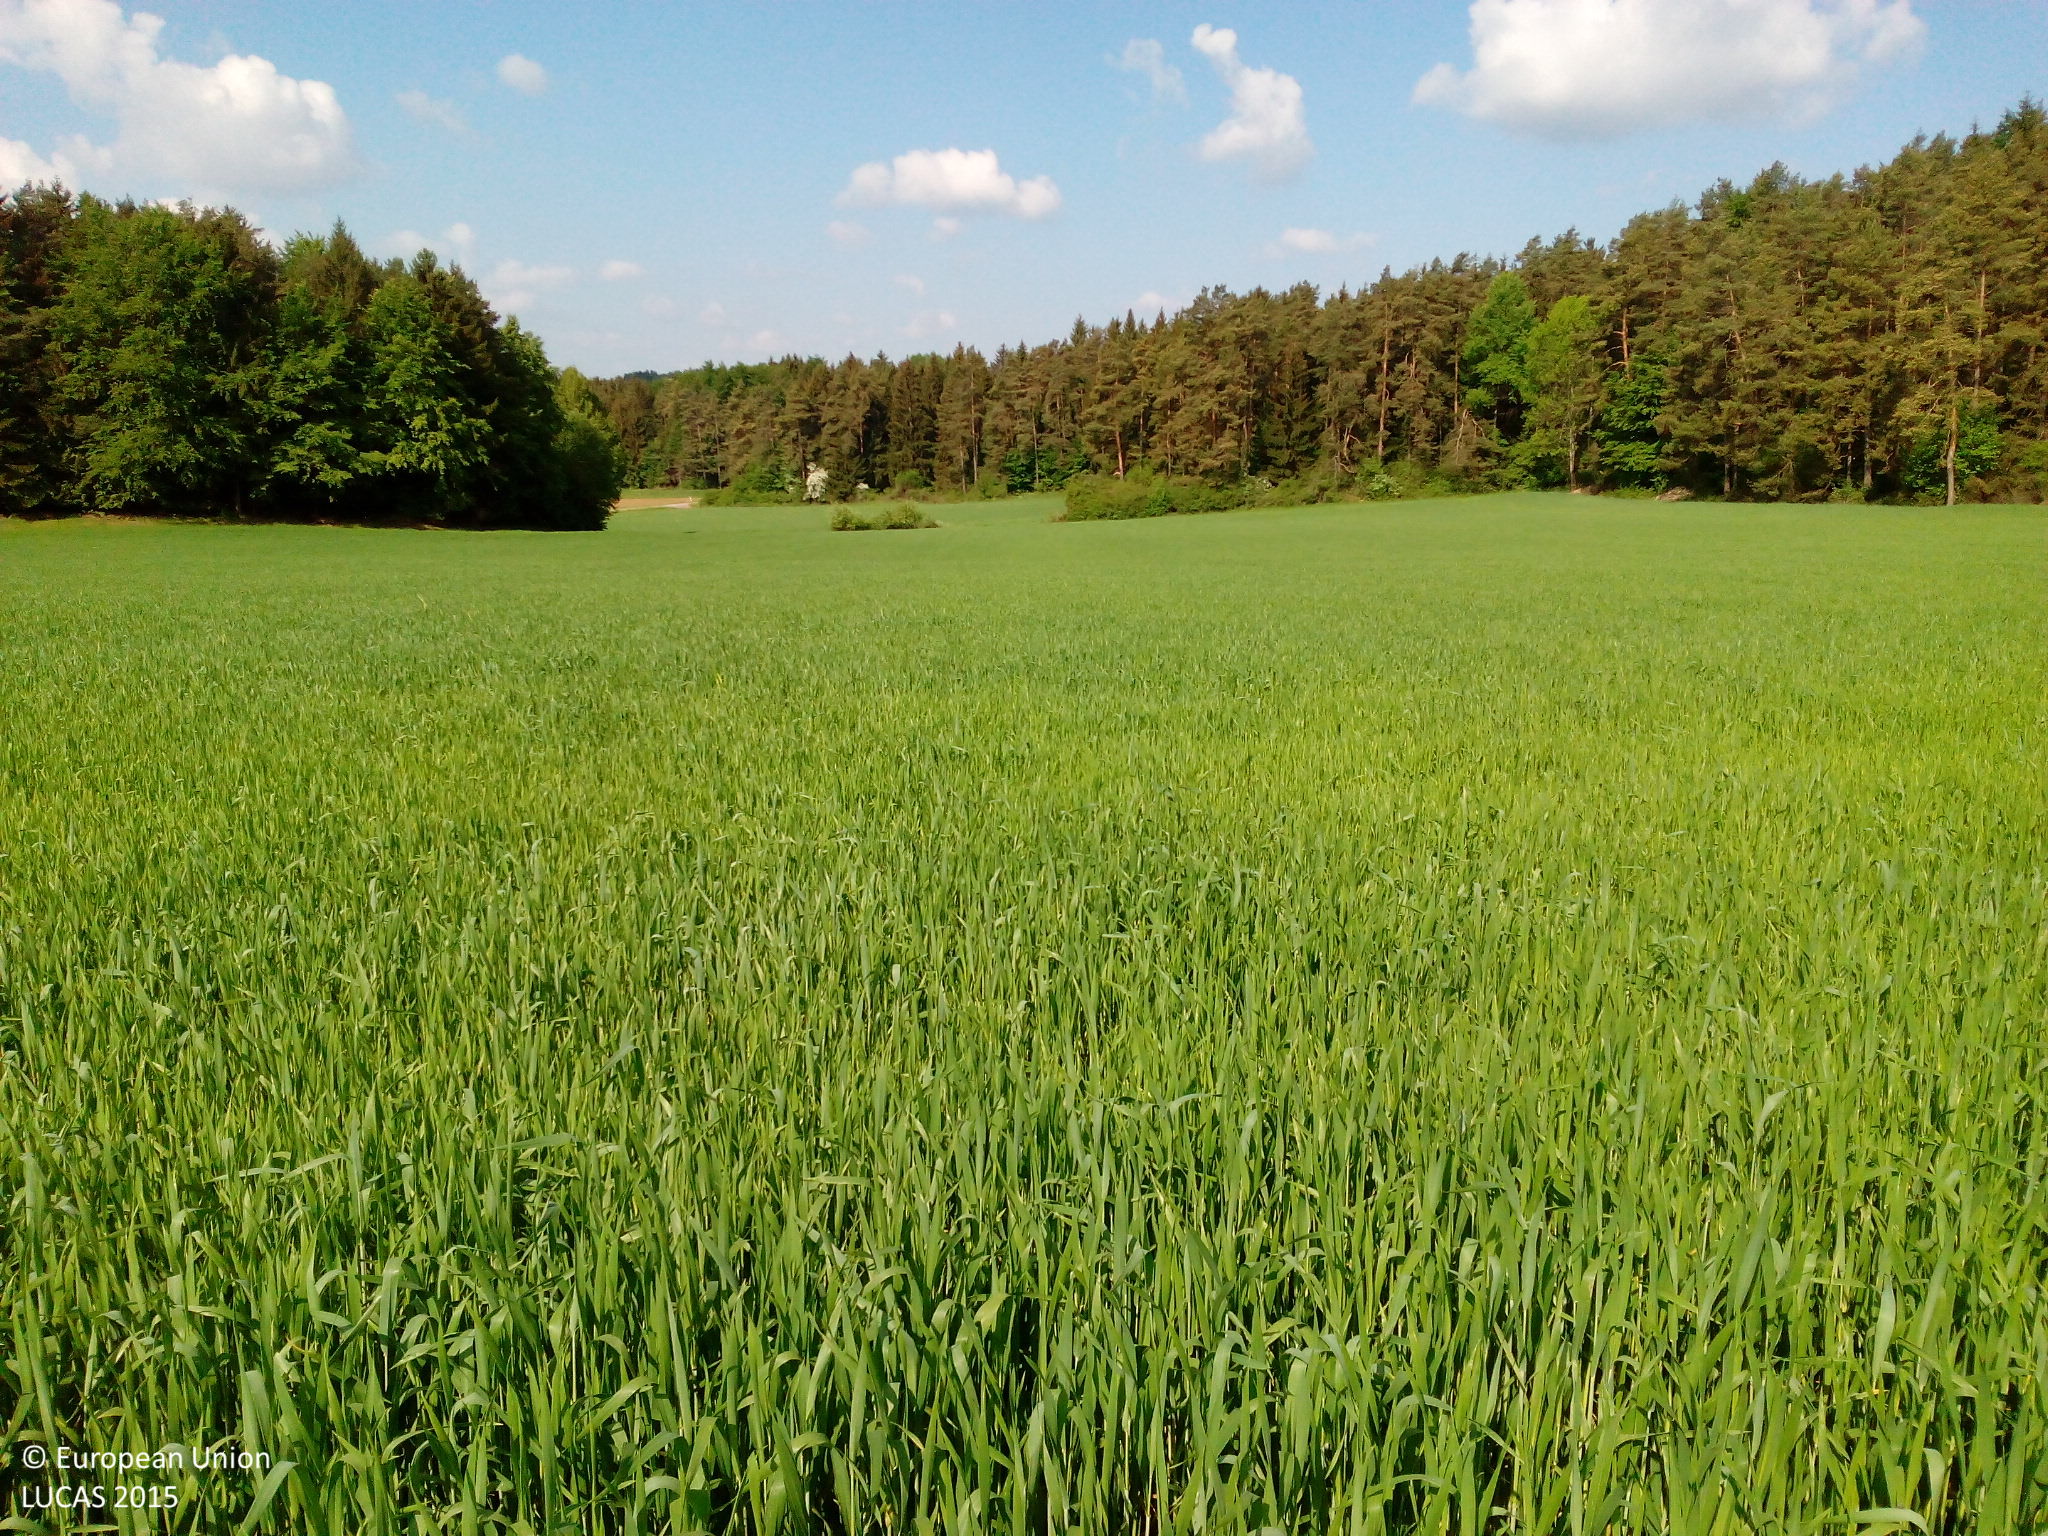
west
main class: Cropland
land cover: Triticale
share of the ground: > 75 %
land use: Agriculture (excluding fallow land and kitchen gardens)
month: May
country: DE
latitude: 49.4357
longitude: 11.5853
